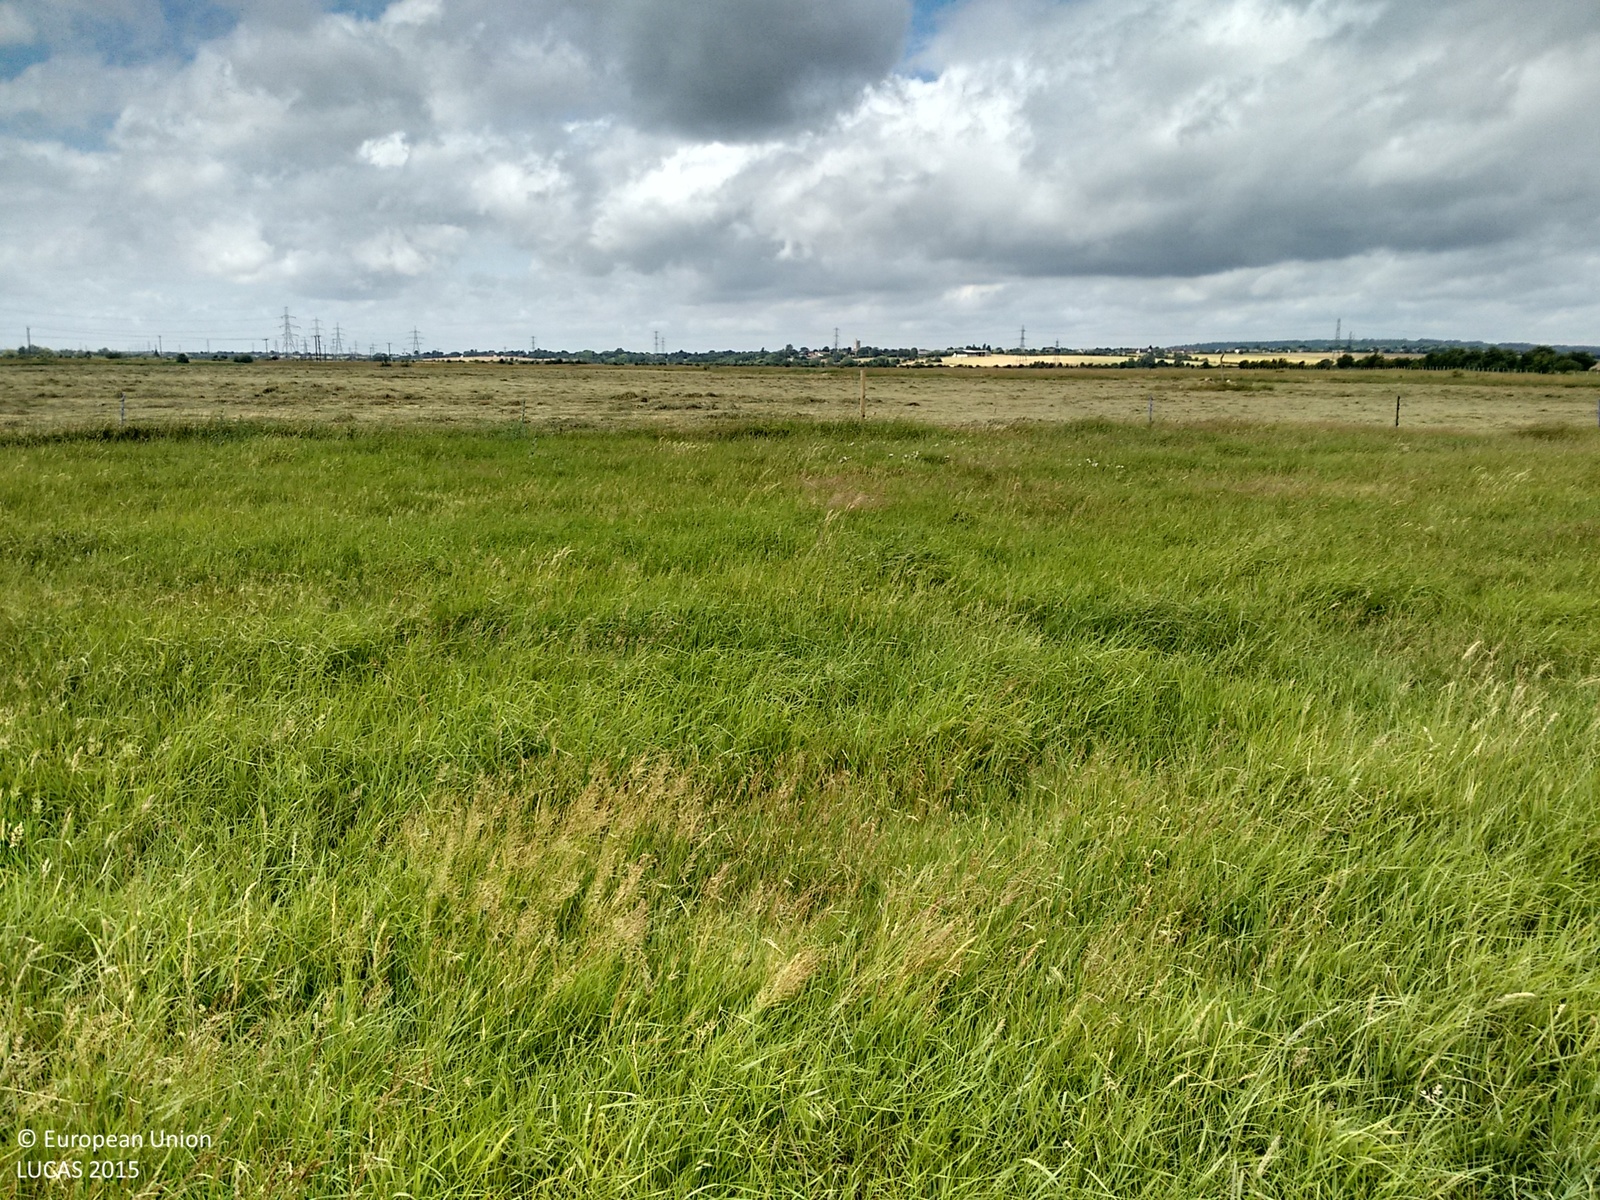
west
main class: Grassland
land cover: Grassland without tree/shrub cover
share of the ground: > 75 %
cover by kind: herbaceous plants 100 %
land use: Agriculture (excluding fallow land and kitchen gardens)
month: July
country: GB
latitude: 51.5252
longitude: 0.5025
